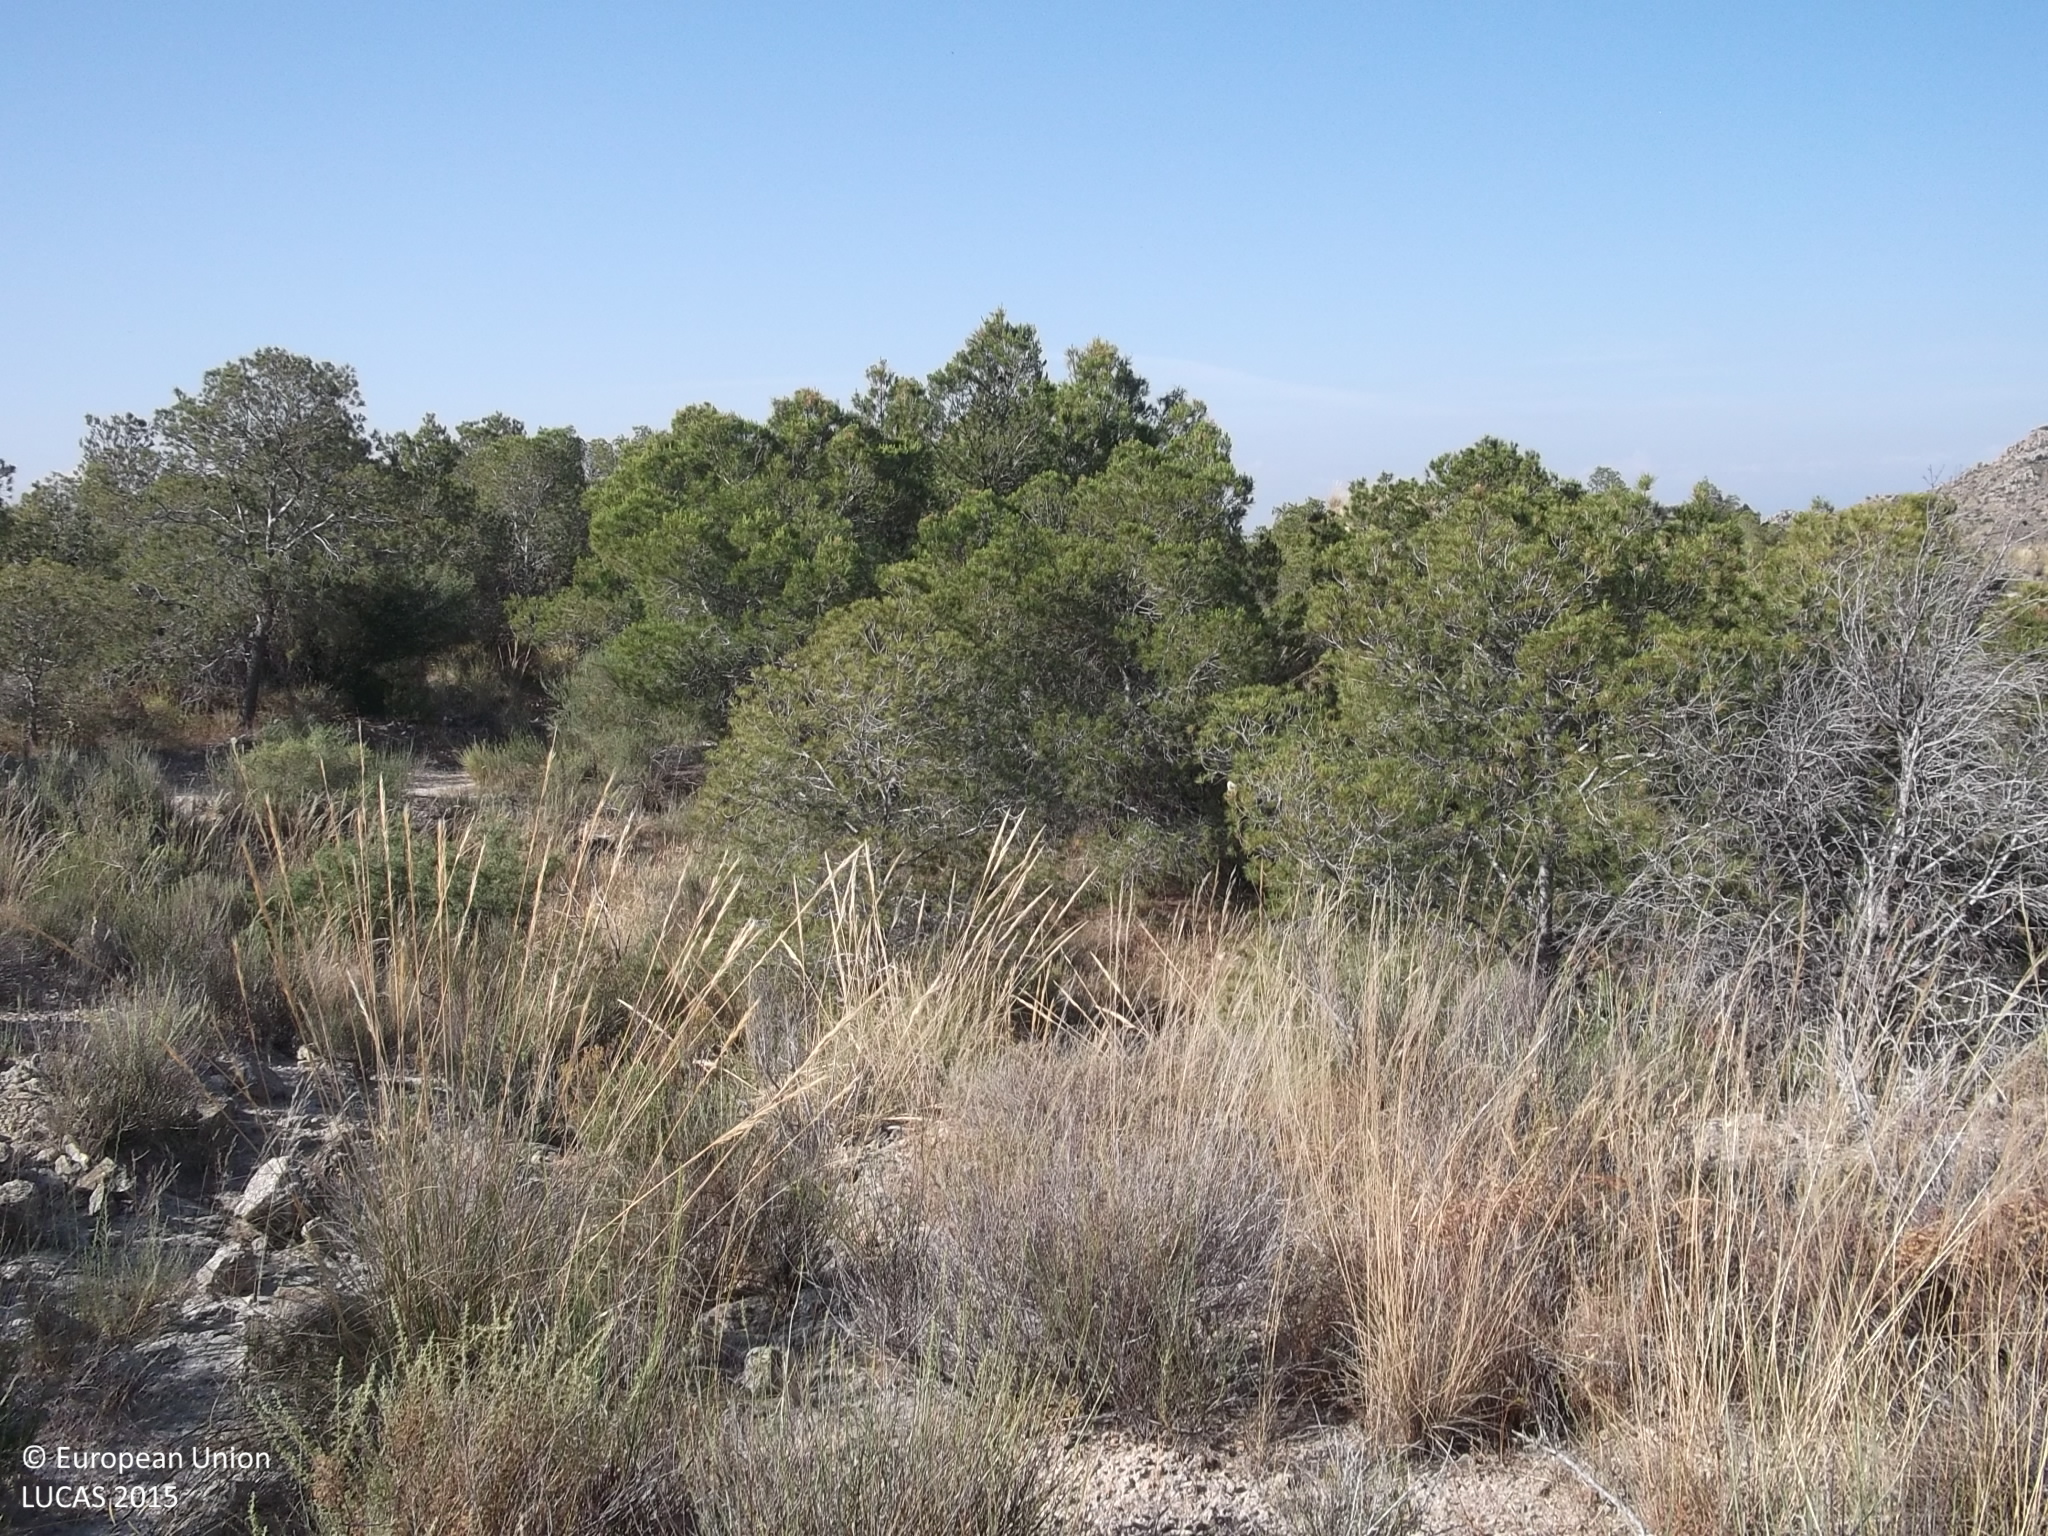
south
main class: Woodland
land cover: Pine dominated coniferous woodland
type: coniferous forest of the mediterranean region
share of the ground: 10 - 25 %
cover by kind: shrubs 30 %, herbaceous plants 30 %, consolidated bare surface 30 %, coniferous forest trees 10 %
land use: Semi-natural and natural areas not in use
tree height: < 5 m
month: May
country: ES
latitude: 38.1335
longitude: -1.2924
